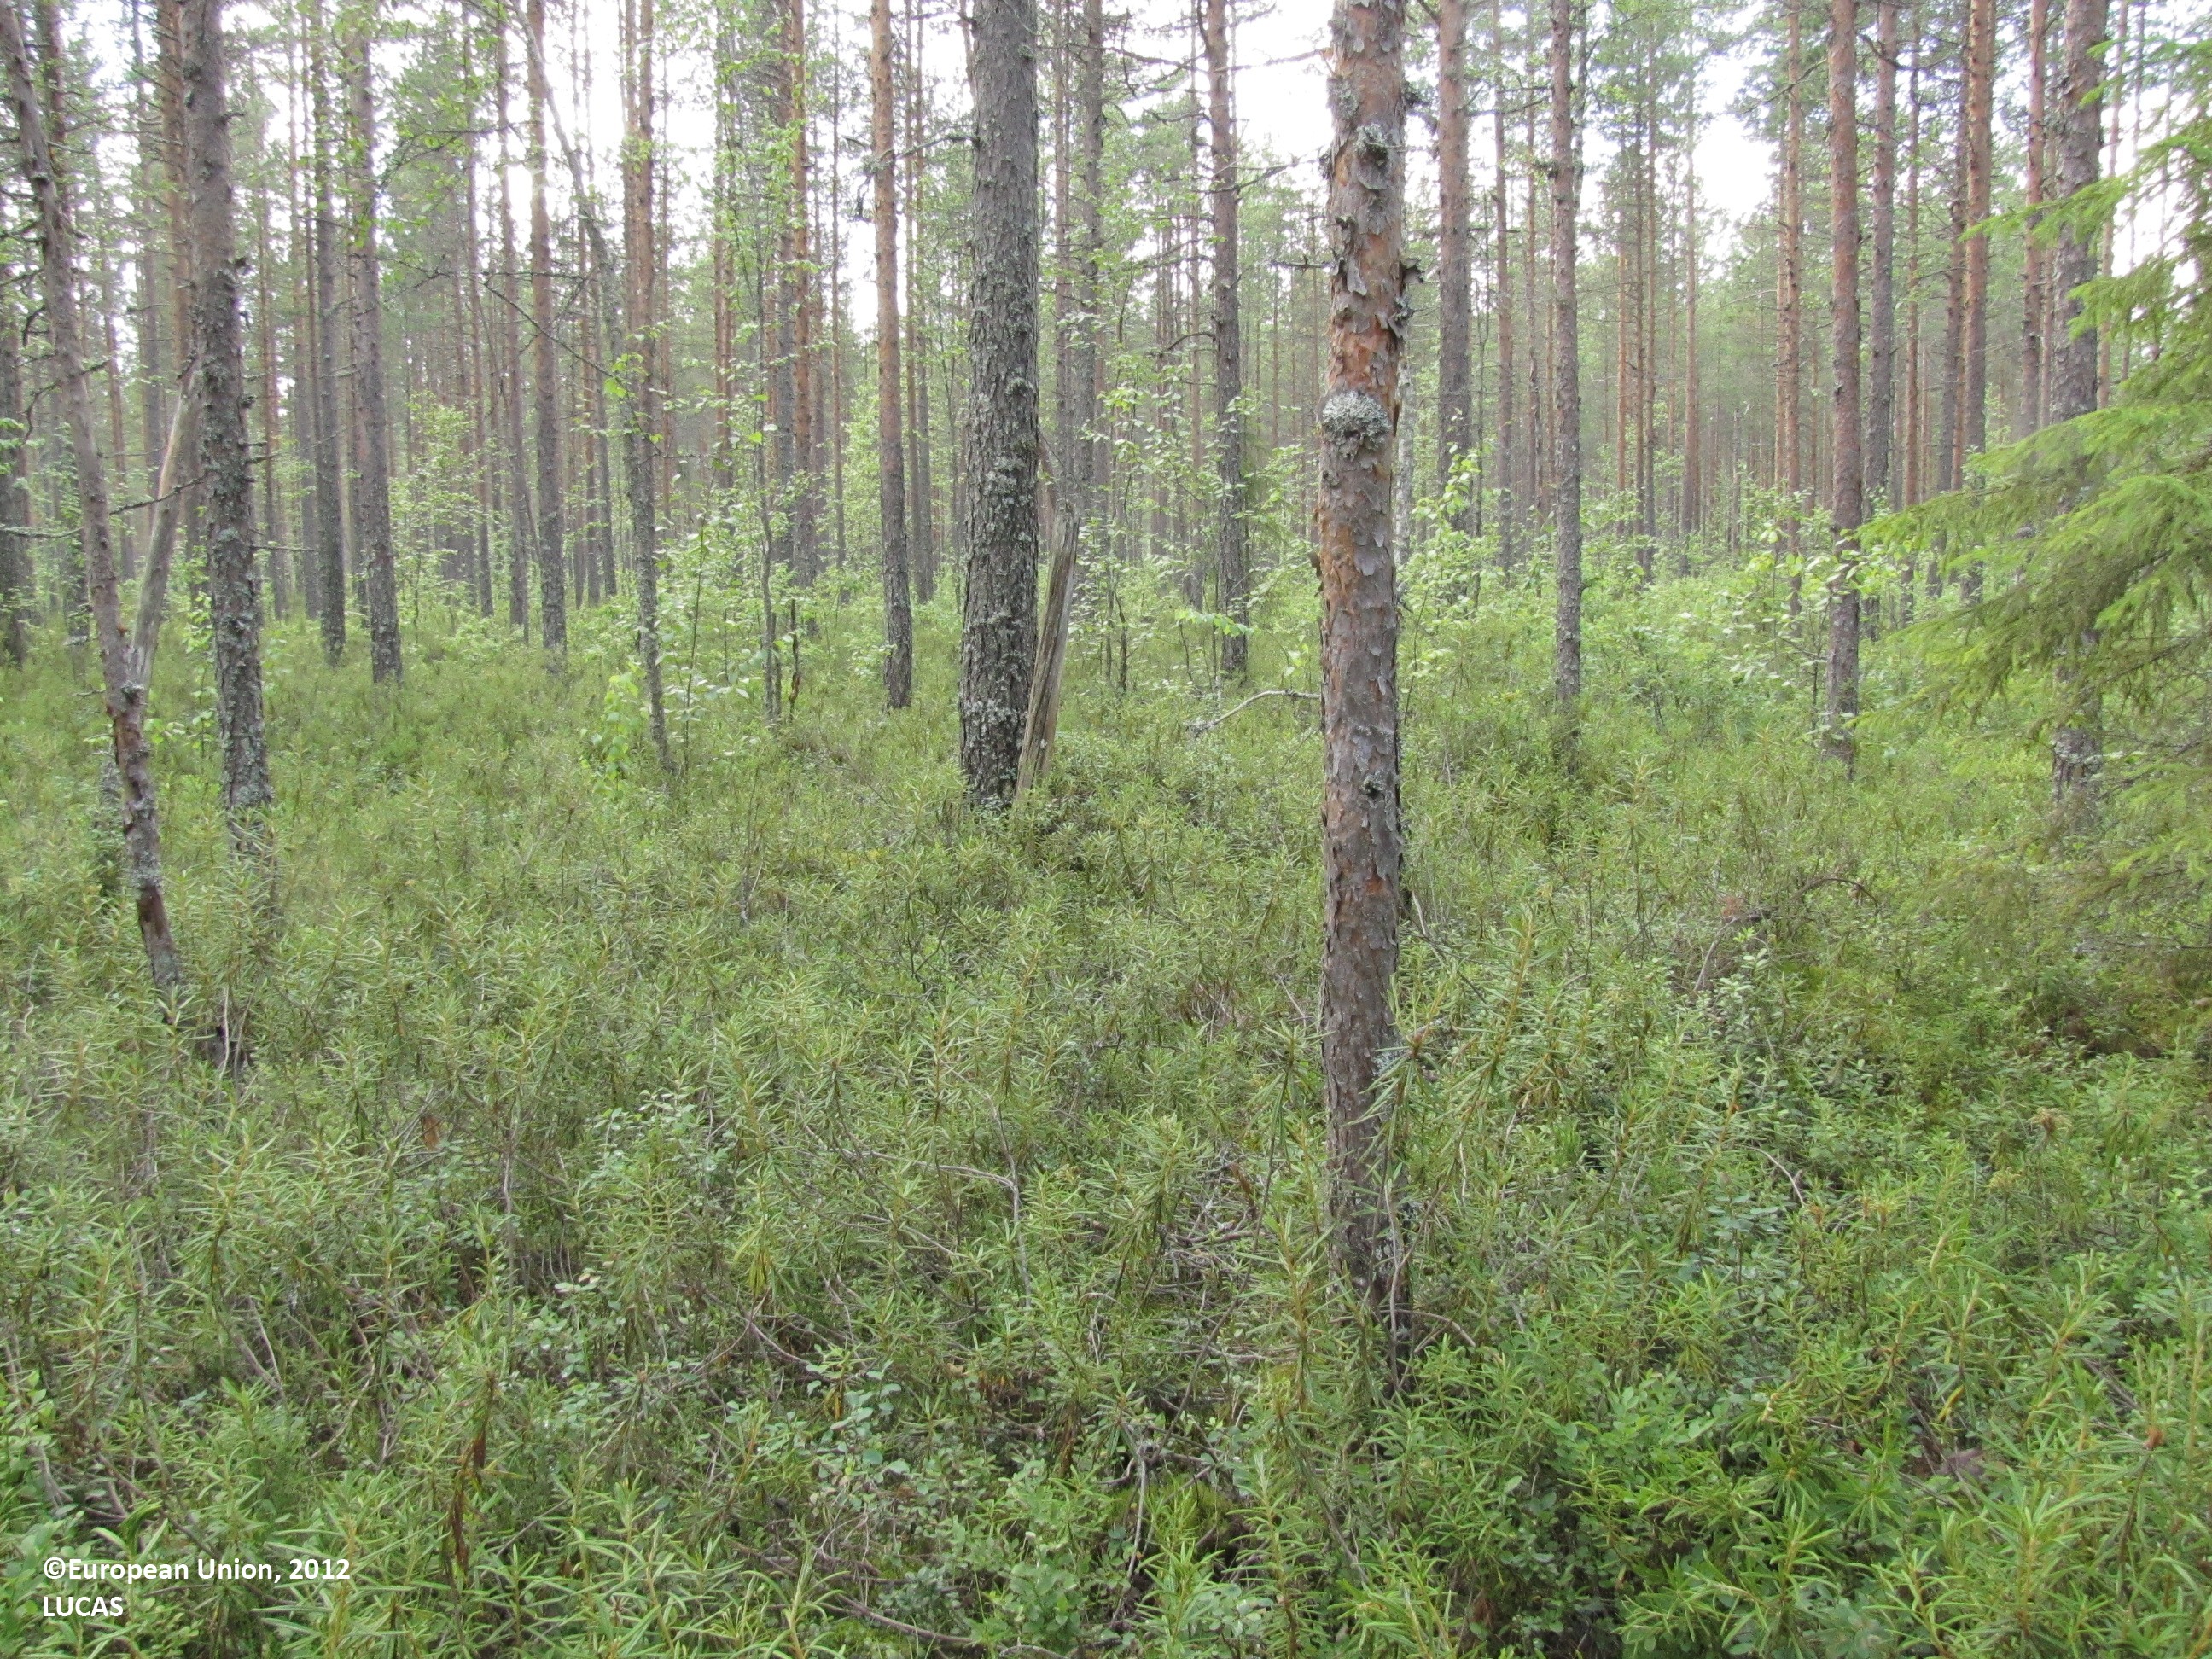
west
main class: Woodland
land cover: Pine dominated coniferous woodland
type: mire and swamp forests
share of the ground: 50 - 75 %
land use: Forestry
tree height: > 5 m
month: July
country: FI
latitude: 62.3672
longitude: 23.5044
